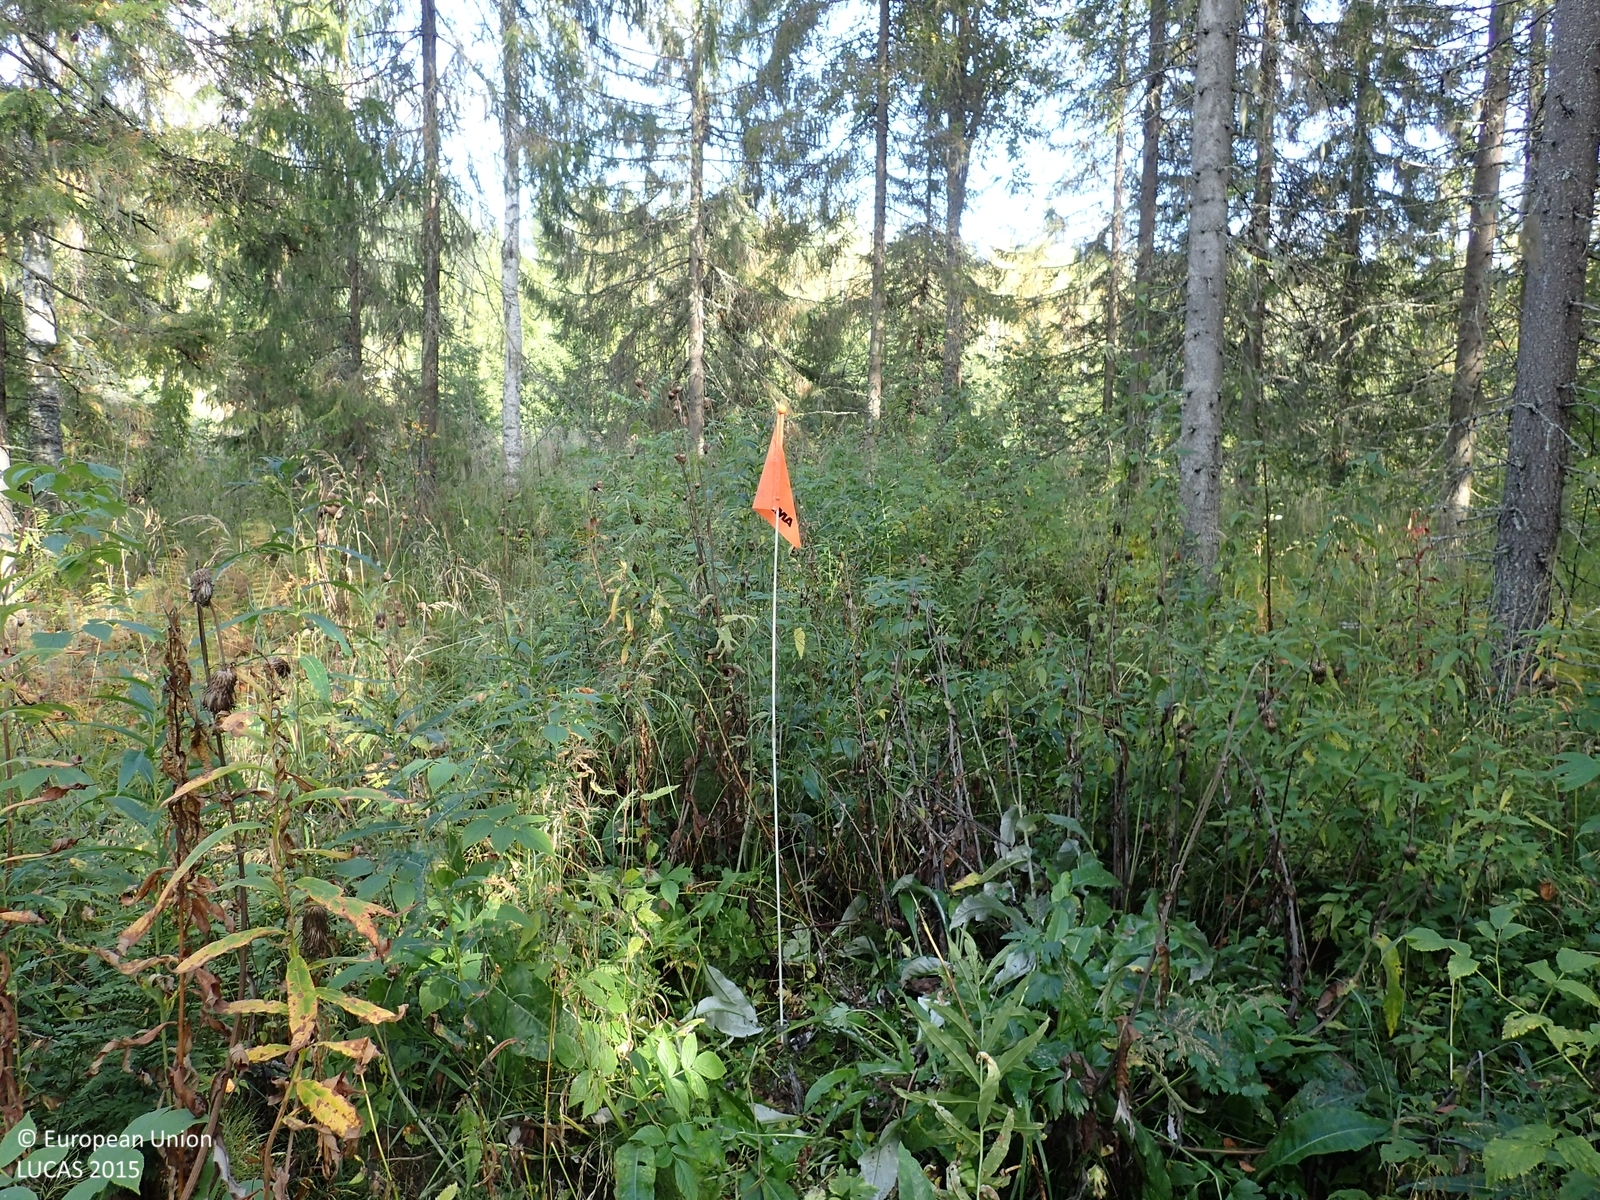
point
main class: Woodland
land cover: Spruce dominated coniferous woodland
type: boreal forest
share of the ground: > 75 %
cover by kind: coniferous forest trees 70 %, herbaceous plants 20 %, broadleaved forest trees 5 %, shrubs 5 %
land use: Forestry
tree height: > 5 m
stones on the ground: < 10 %
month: September
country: FI
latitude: 63.1859
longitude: 25.5042
